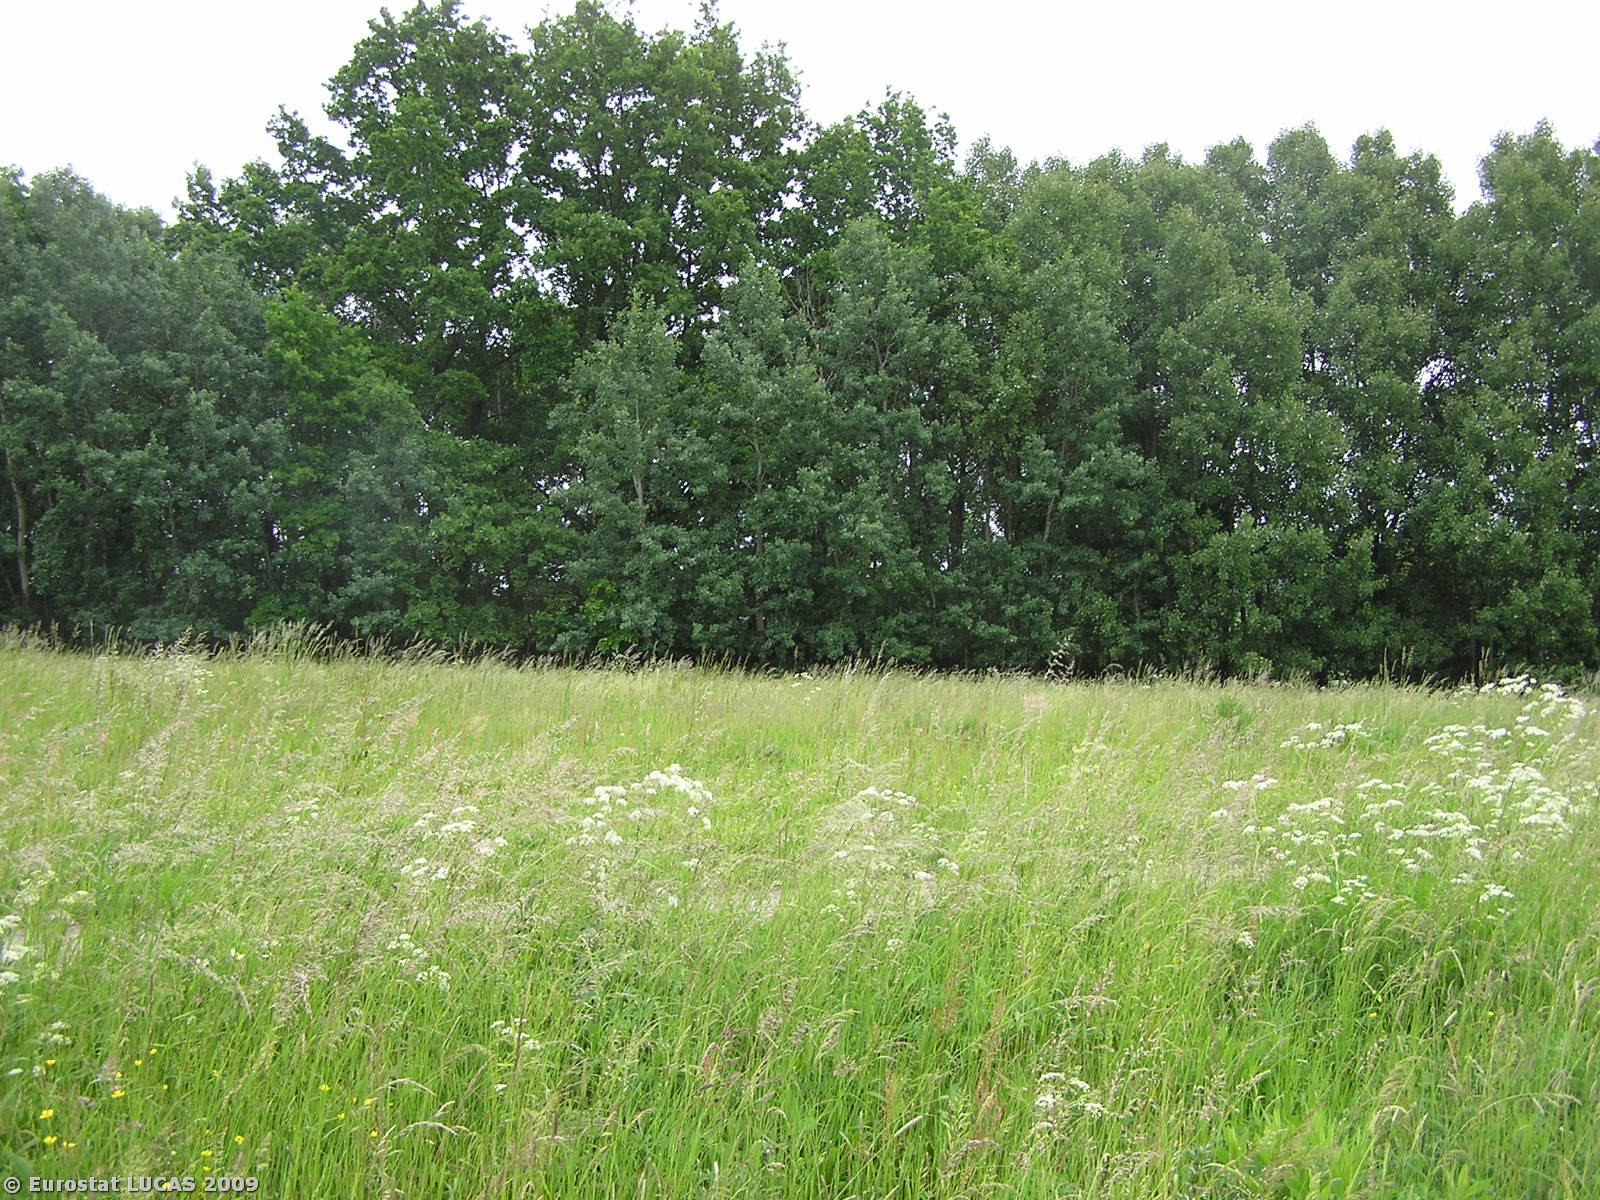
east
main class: Grassland
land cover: Grassland without tree/shrub cover
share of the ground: > 75 %
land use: Agriculture (excluding fallow land and kitchen gardens)
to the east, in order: Grassland without tree/shrub cover; Paved roads, cycling and walking lanes; Grassland without tree/shrub cover; Broadleaved woodland; Railways; Broadleaved woodland; Barley; Maize
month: June
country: CZ
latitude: 50.0551
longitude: 17.6253
